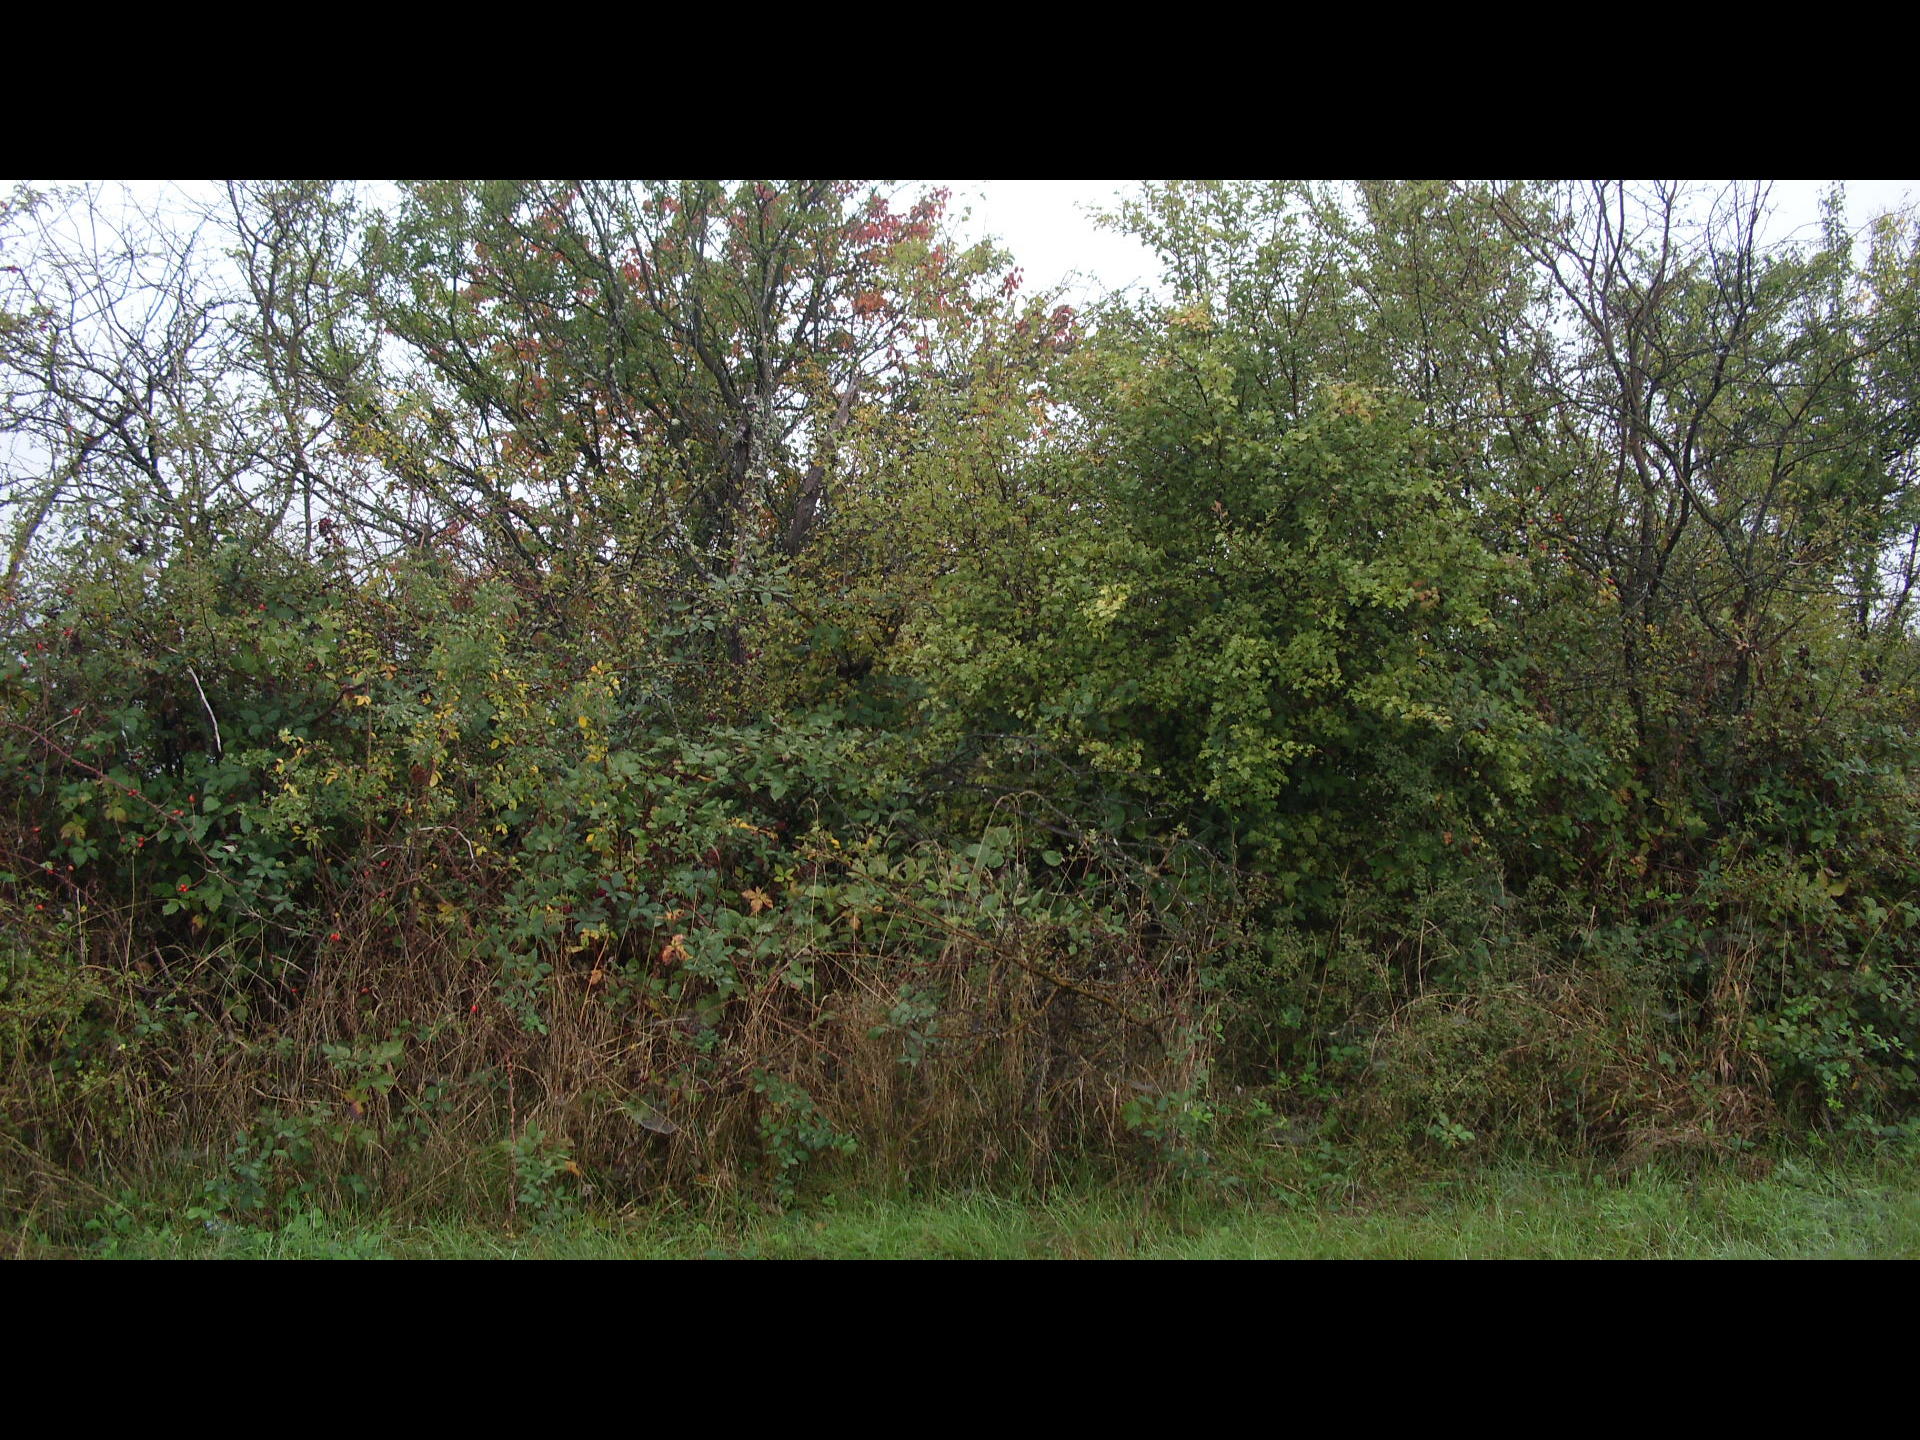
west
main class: Grassland
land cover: Grassland without tree/shrub cover
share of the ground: > 75 %
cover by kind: herbaceous plants 95 %, unconsolidated bare surface 5 %
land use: Agriculture (excluding fallow land and kitchen gardens)
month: October
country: BG
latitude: 43.5191
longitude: 22.7893
